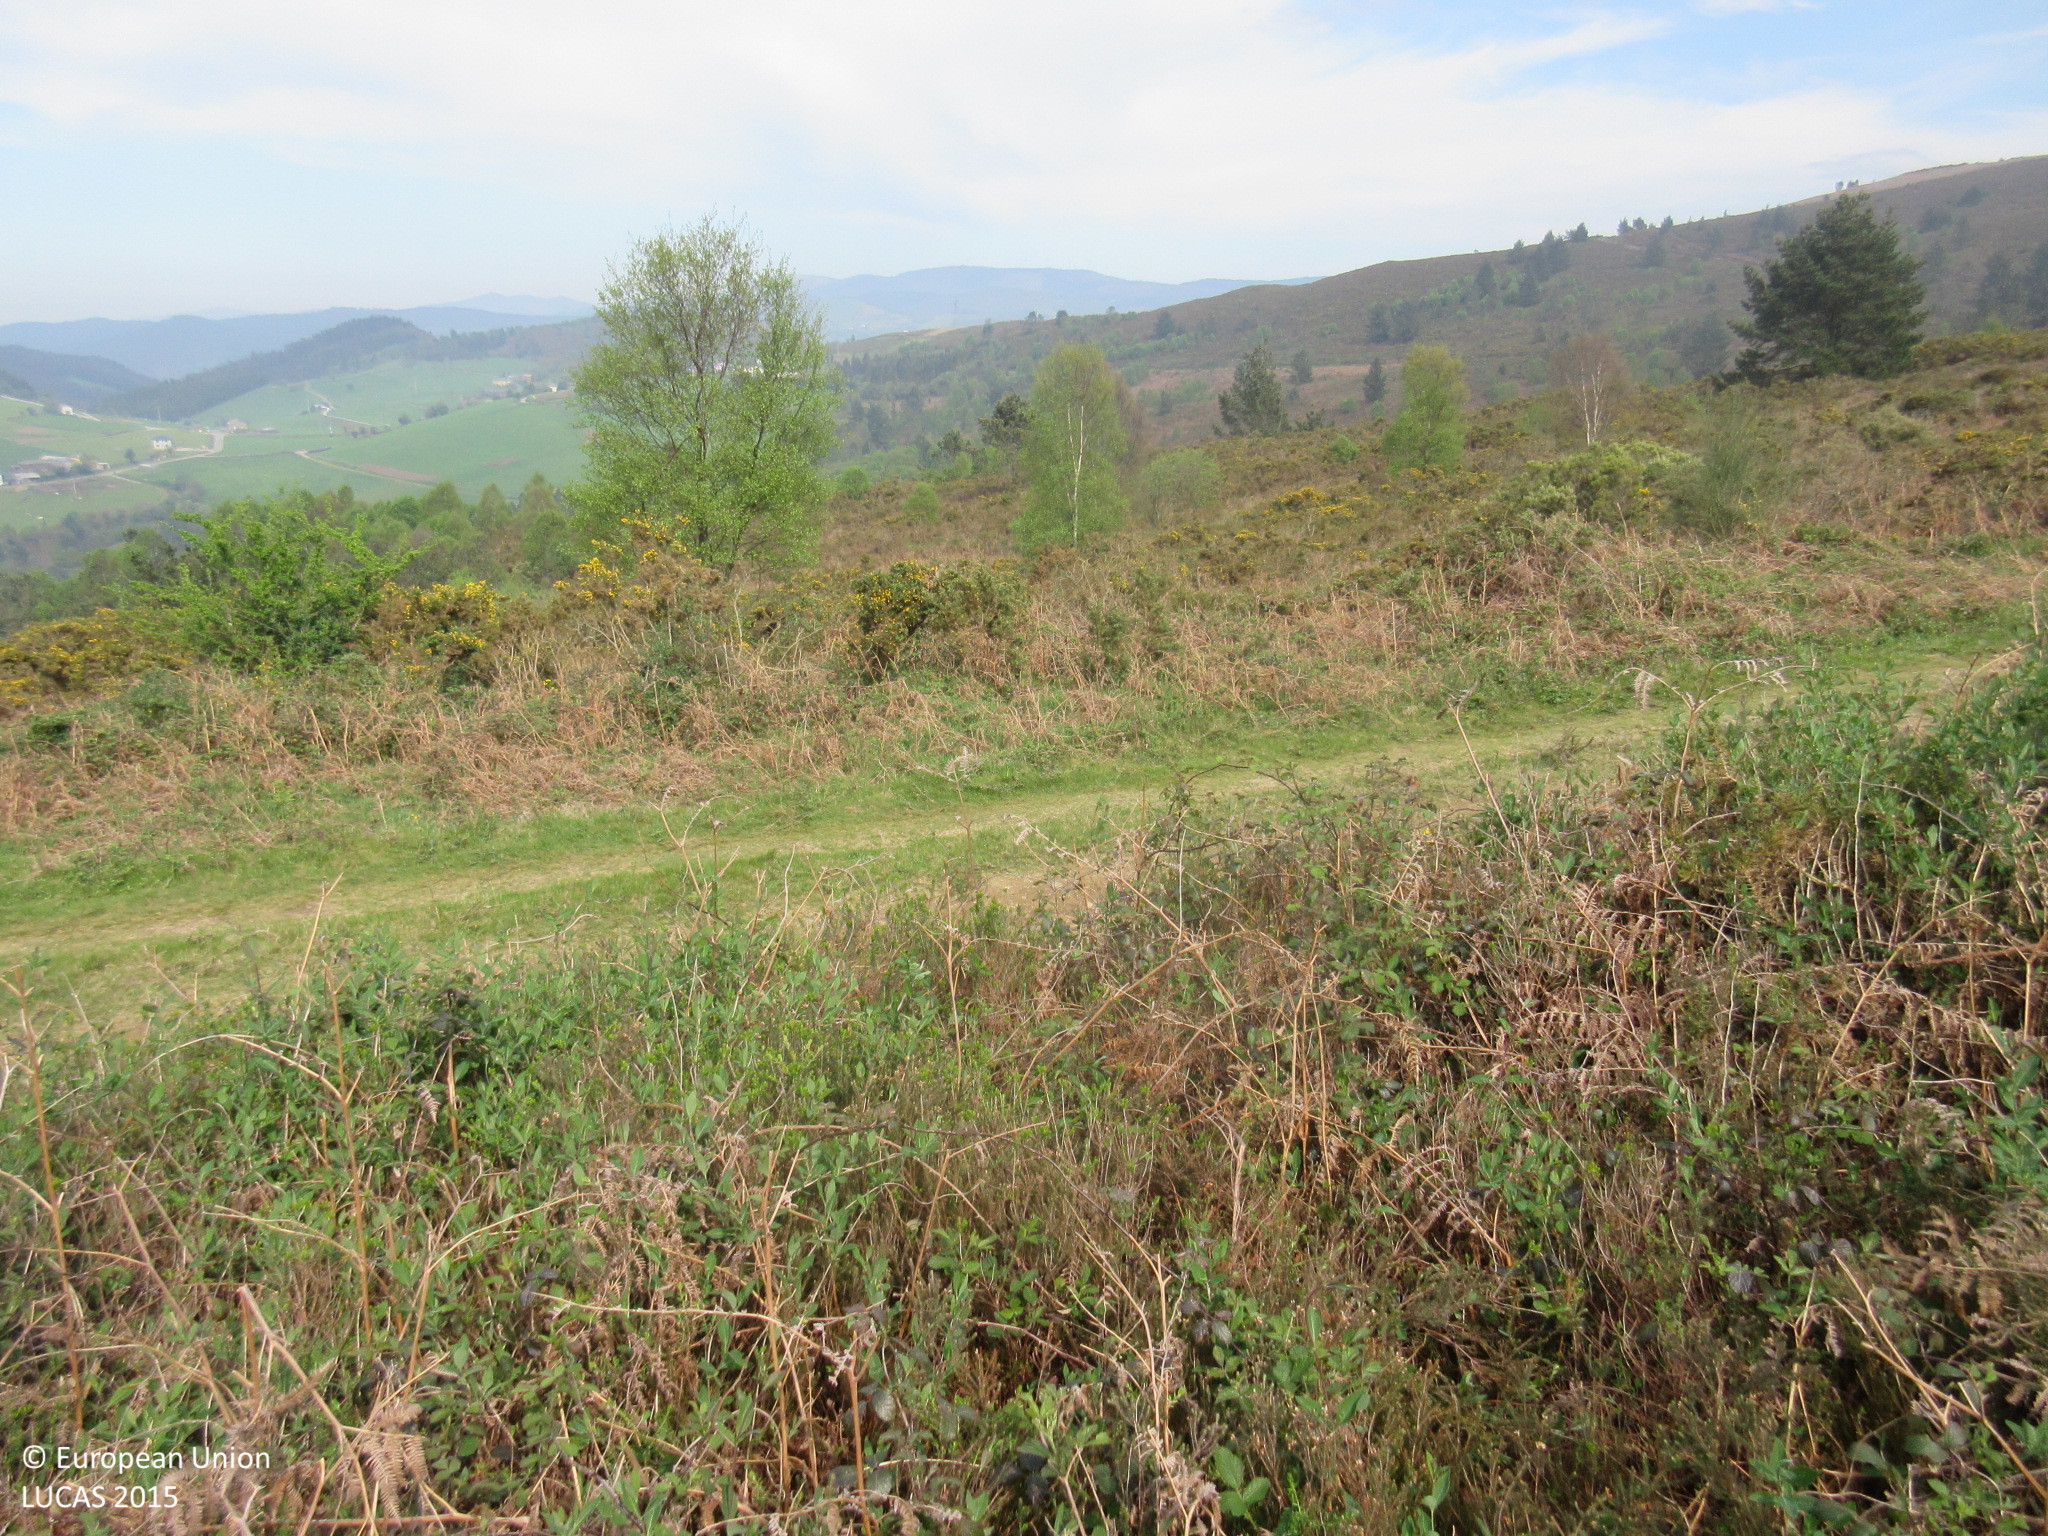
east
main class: Shrubland
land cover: Shrubland without tree cover
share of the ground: > 75 %
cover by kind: shrubs 100 %
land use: Semi-natural and natural areas not in use
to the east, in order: Shrubland without tree cover; Tracks; Shrubland with sparse tree cover; Shrubland without tree cover; Shrubland with sparse tree cover
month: April
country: ES
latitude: 43.4396
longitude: -6.9556
